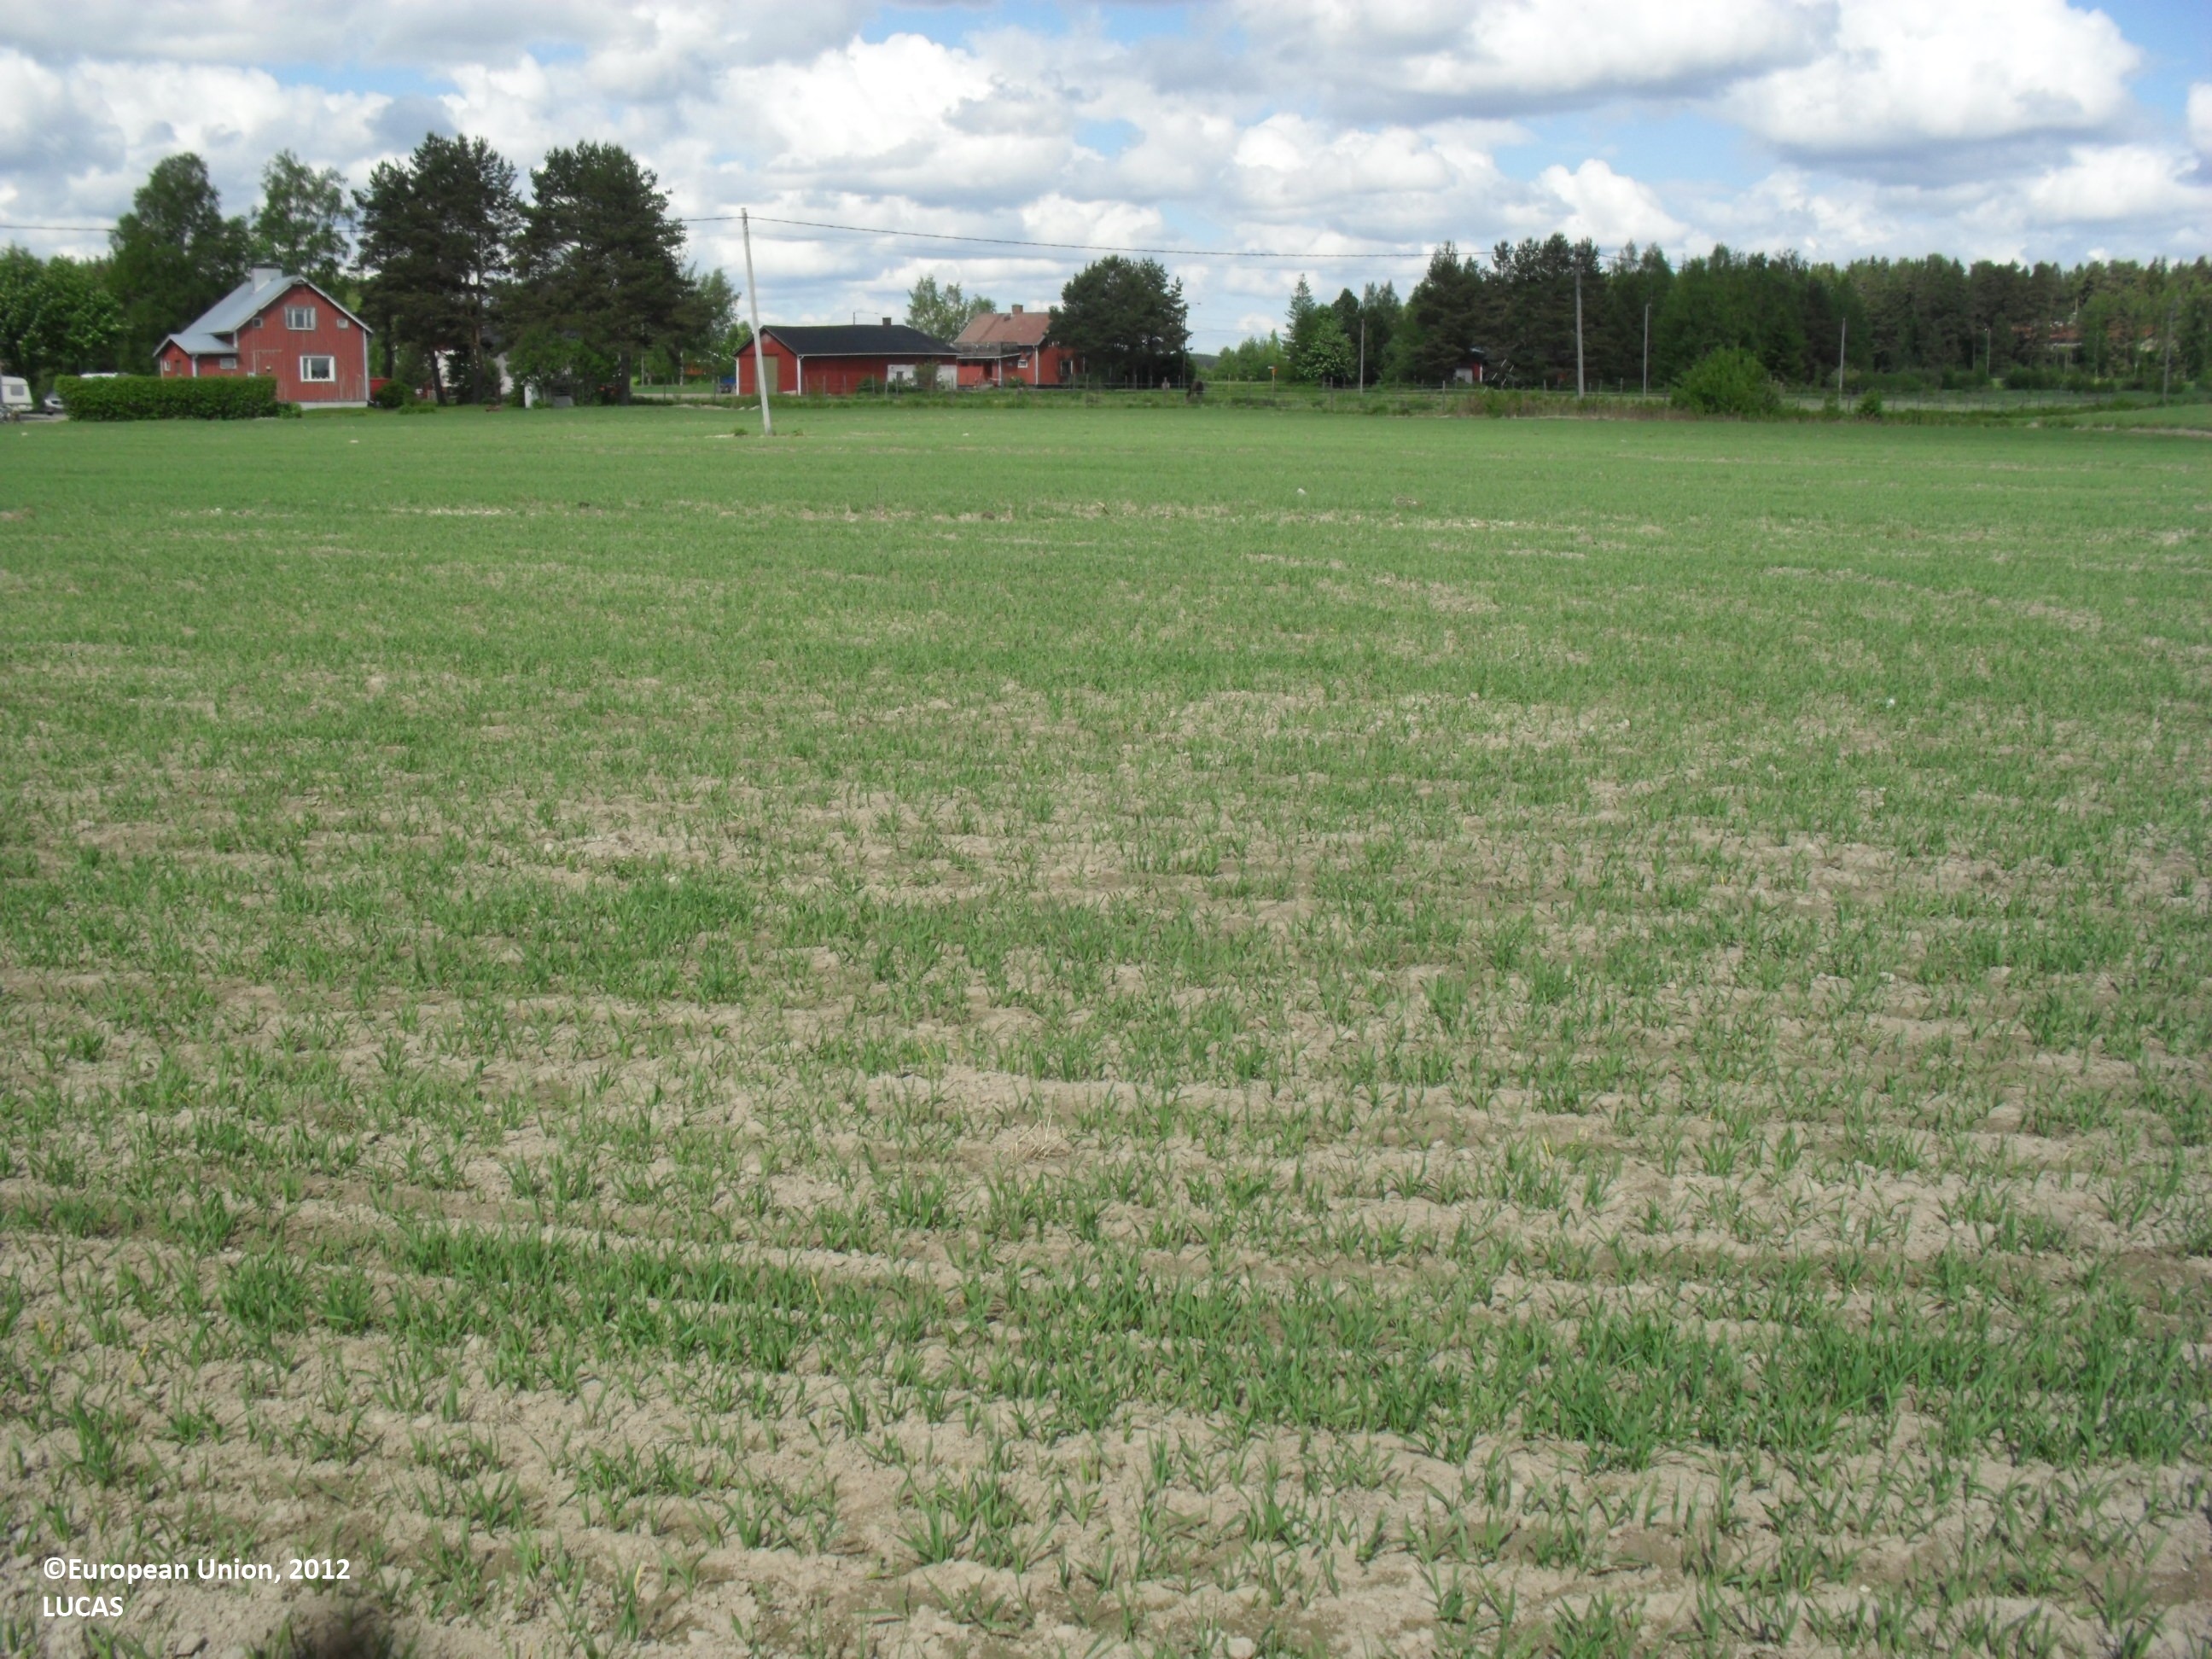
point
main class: Cropland
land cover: Barley
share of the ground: < 10 %
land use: Agriculture (excluding fallow land and kitchen gardens)
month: June
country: FI
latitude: 62.8463
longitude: 23.4822
